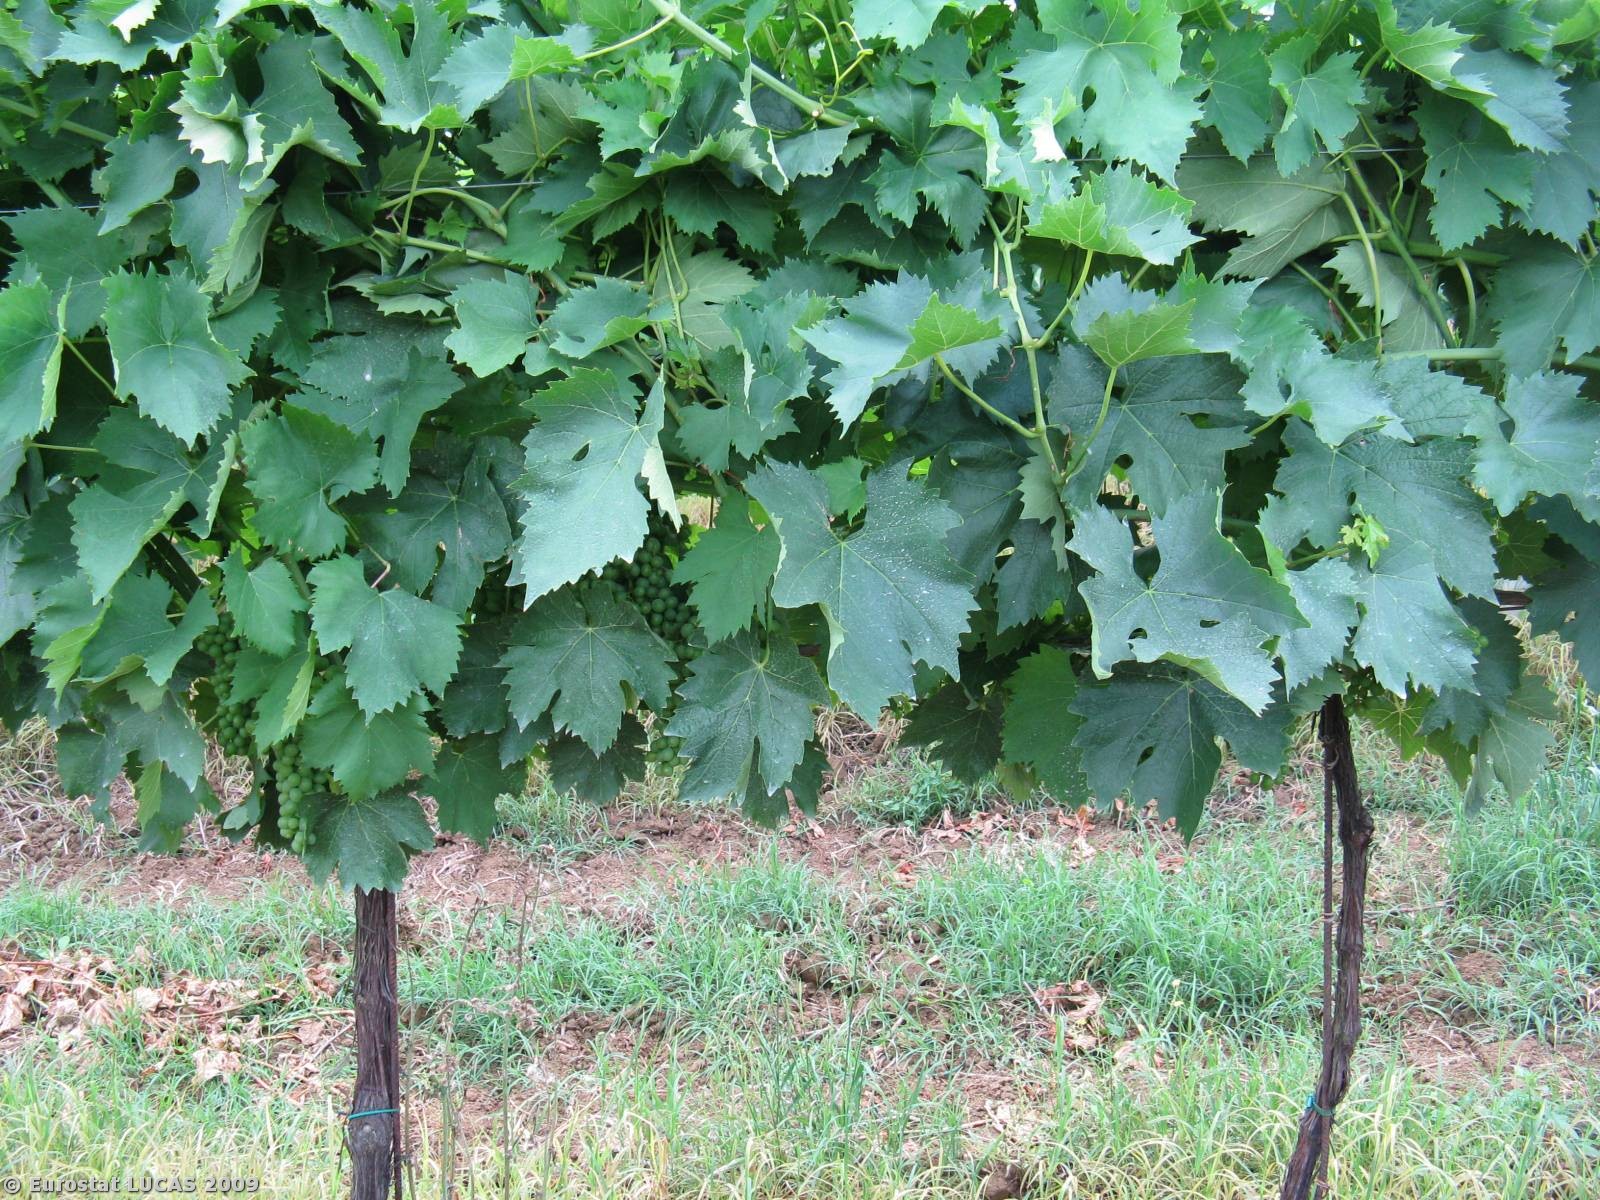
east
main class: Cropland
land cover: Vineyards
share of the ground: 25 - 50 %
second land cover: Bare land
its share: > 75 %
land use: Agriculture (excluding fallow land and kitchen gardens)
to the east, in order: Vineyards; Grassland with sparse tree/shrub cover; Dry pulses; Shrubland with sparse tree cover; Tracks; Other fruit trees and berries; Grassland with sparse tree/shrub cover
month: June
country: IT
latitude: 44.3184
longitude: 11.7139
